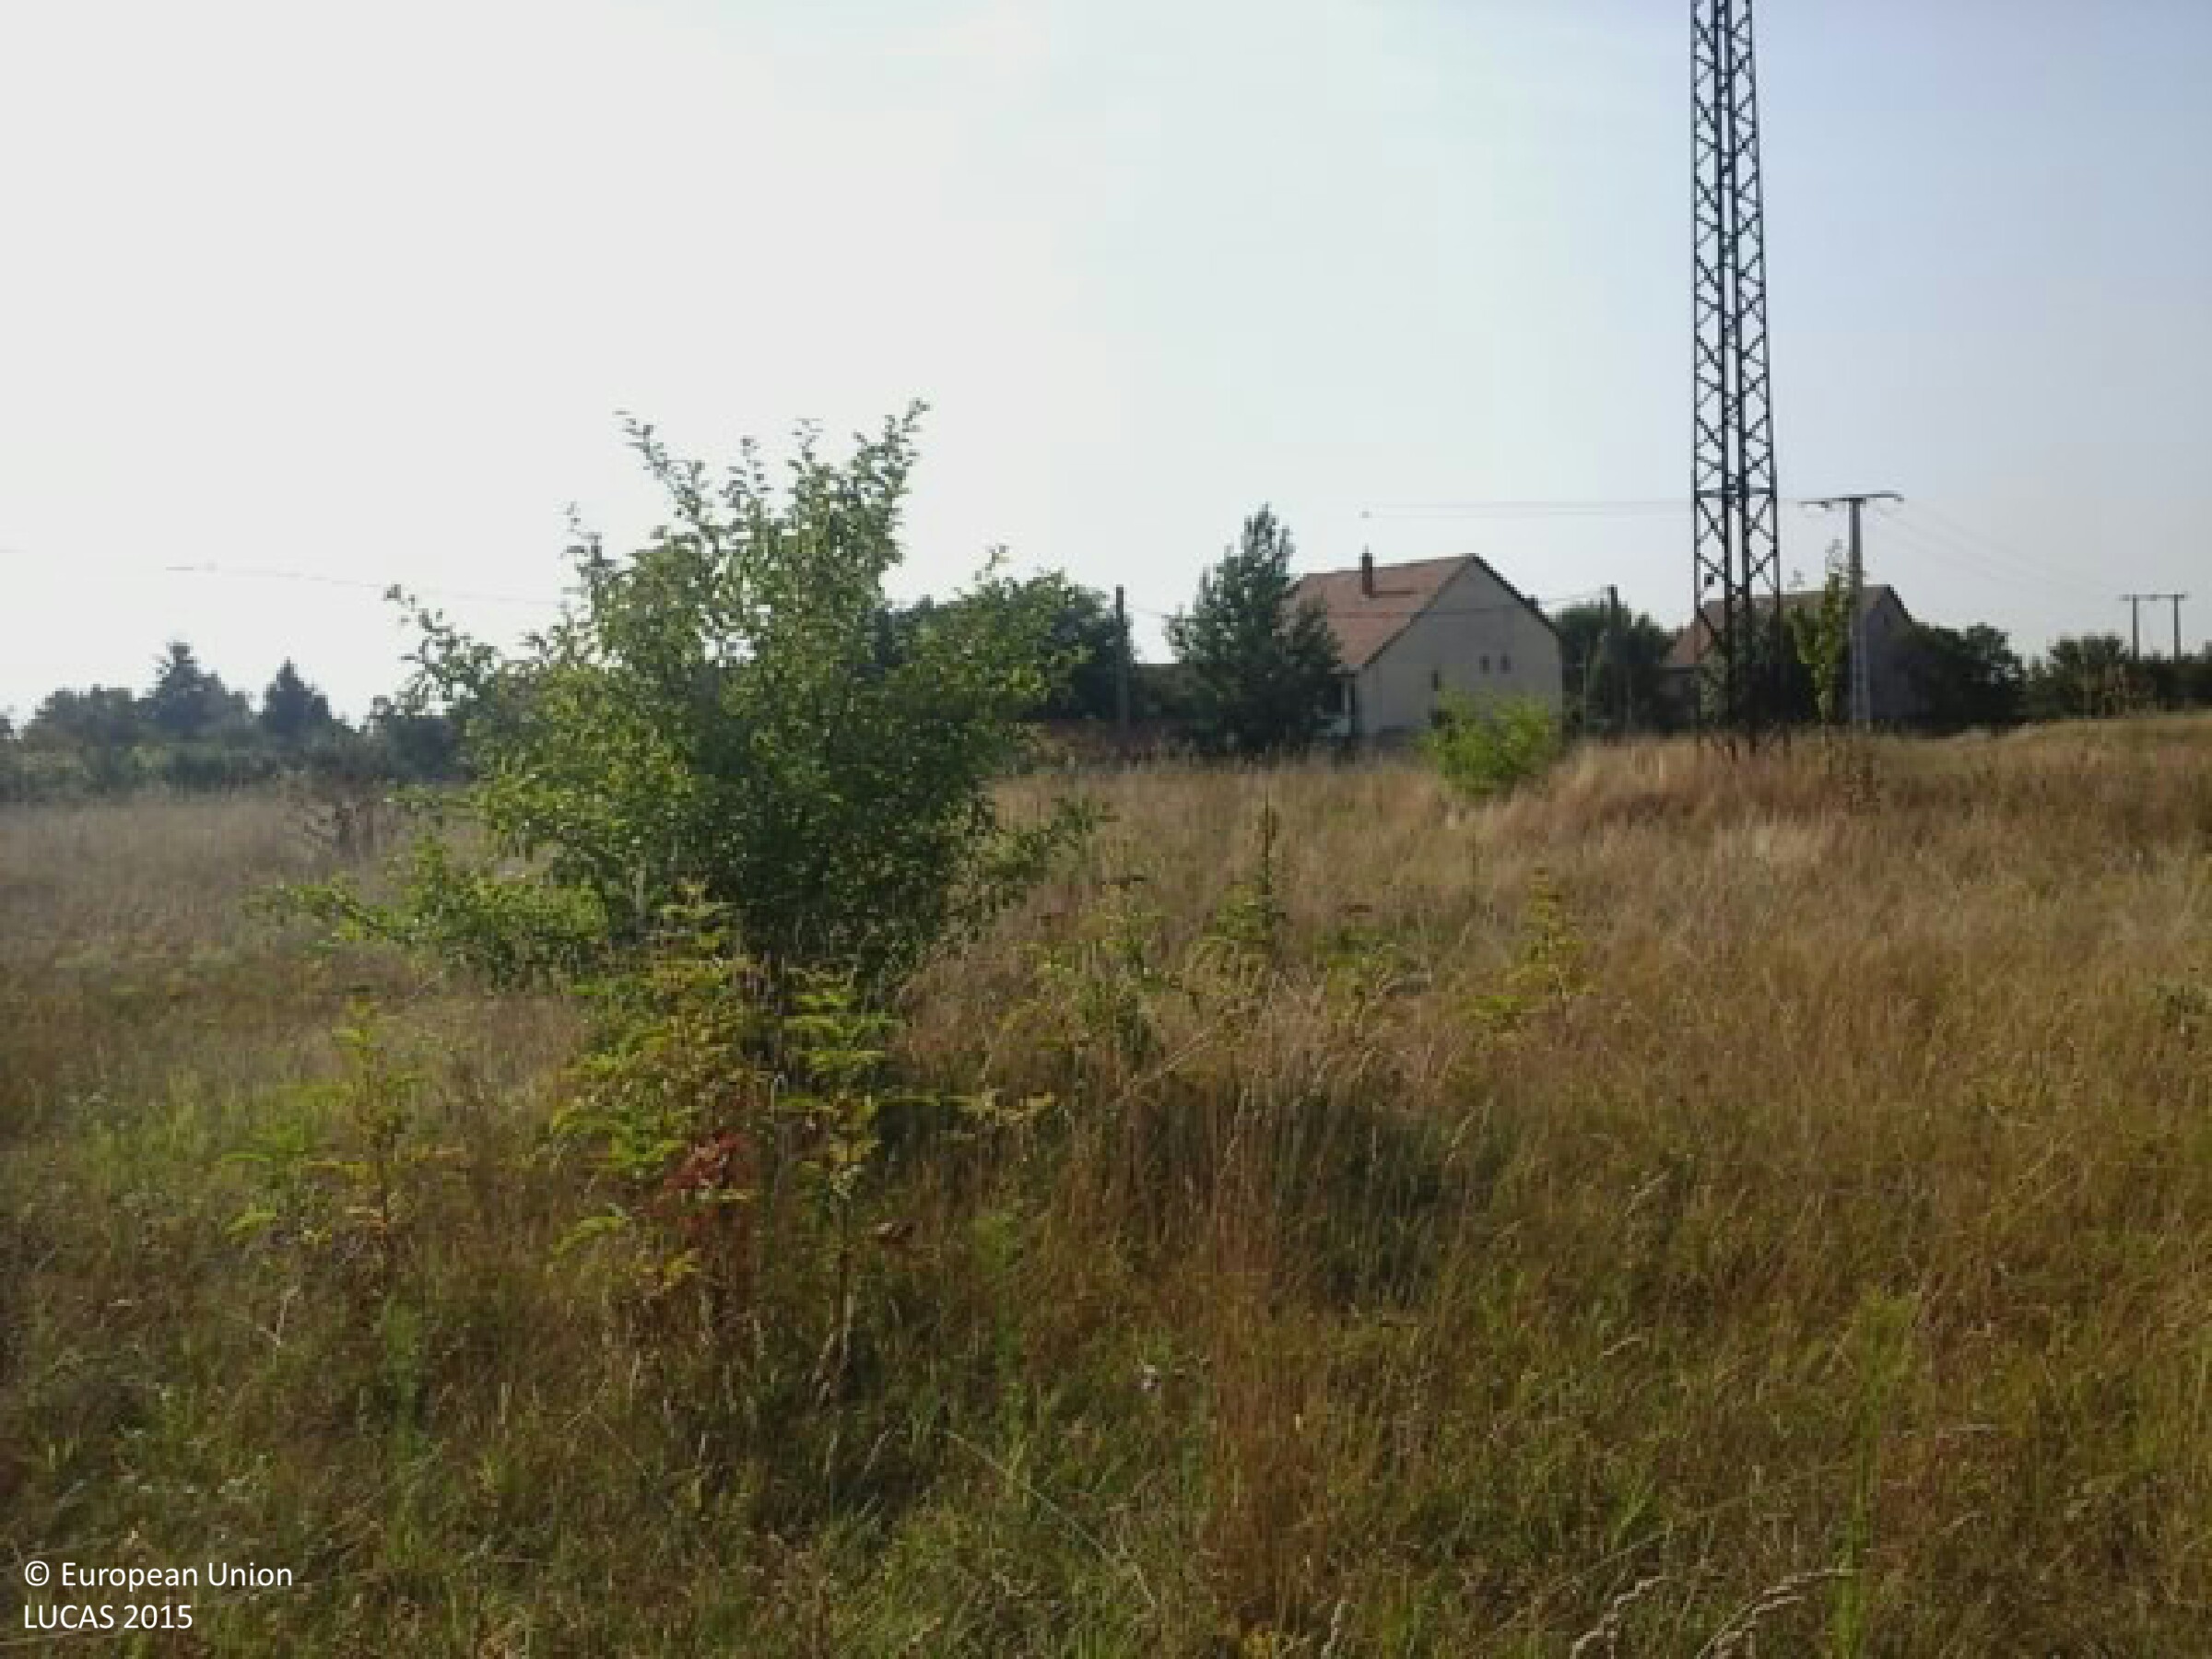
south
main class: Cropland
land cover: Cherry fruit
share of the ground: 50 - 75 %
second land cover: Other bare soil
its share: > 75 %
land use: Agriculture (excluding fallow land and kitchen gardens)
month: July
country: HU
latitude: 47.5988
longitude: 20.2567
